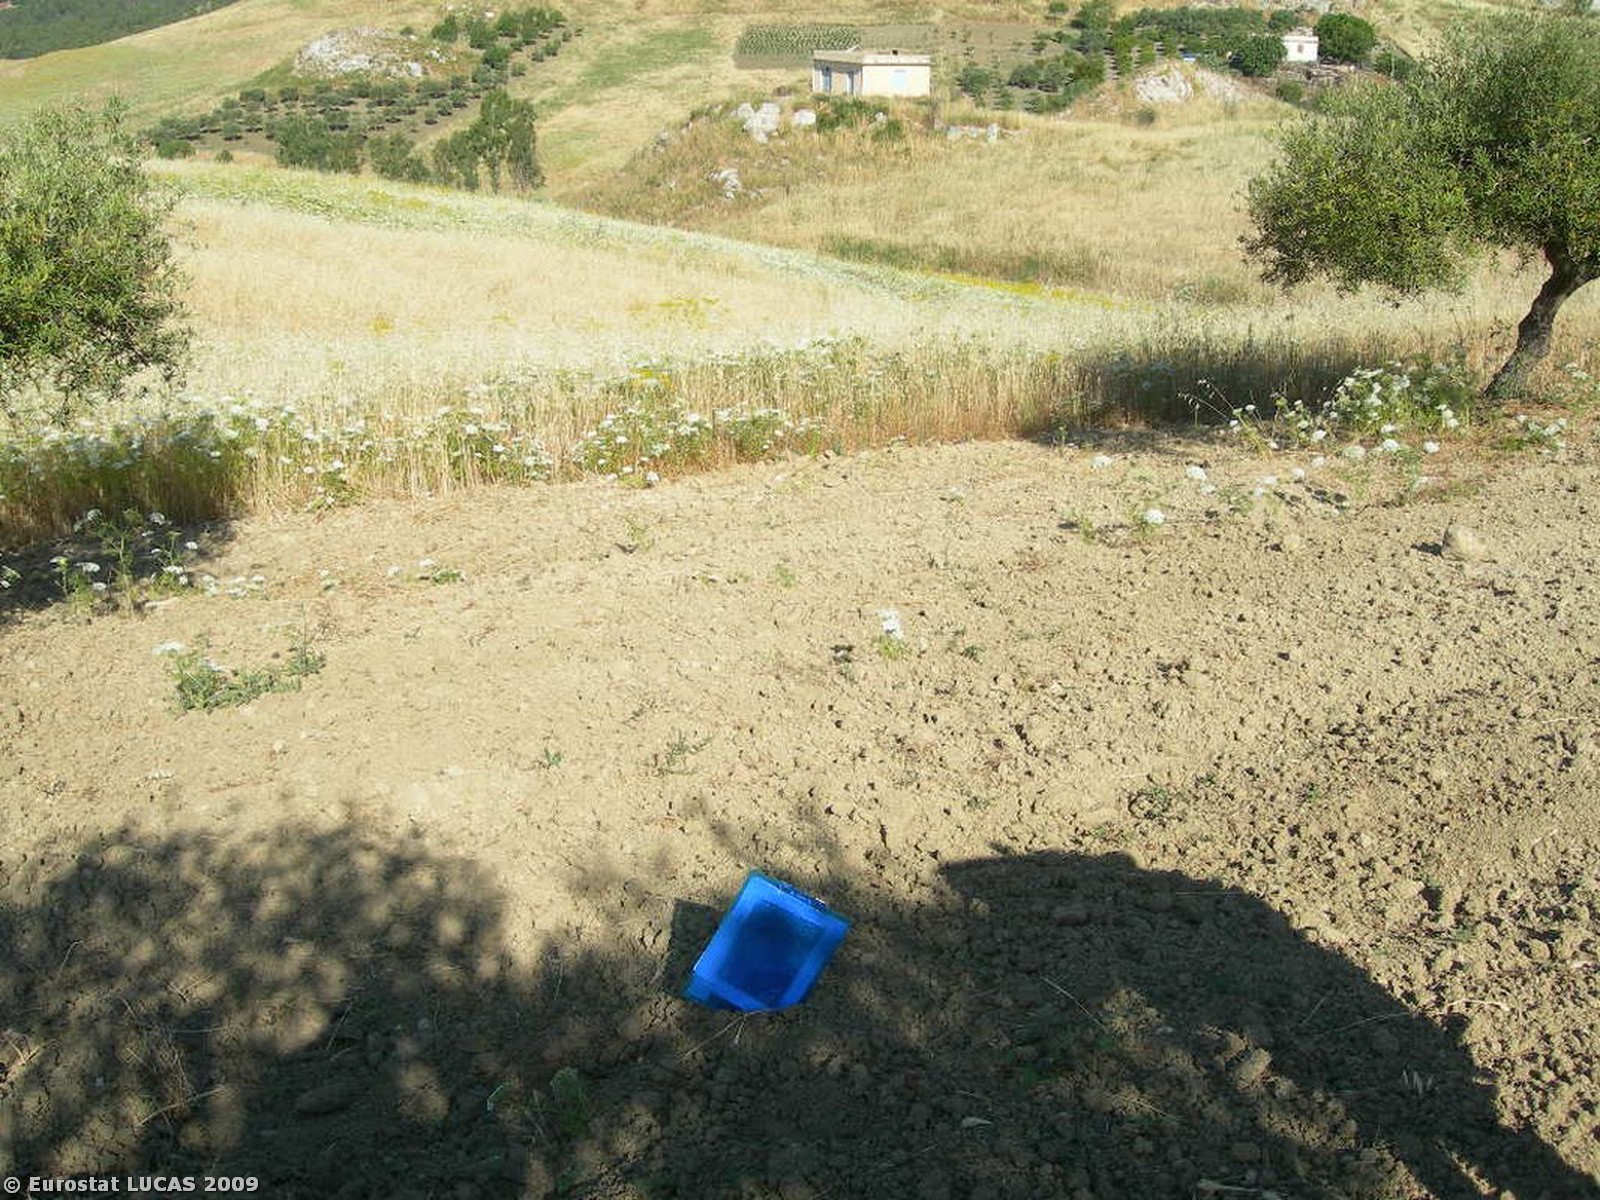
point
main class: Cropland
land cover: Olive groves
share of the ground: 25 - 50 %
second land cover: Bare land
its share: > 75 %
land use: Agriculture (excluding fallow land and kitchen gardens)
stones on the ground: < 10 %
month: June
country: IT
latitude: 37.3764
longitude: 13.4402
